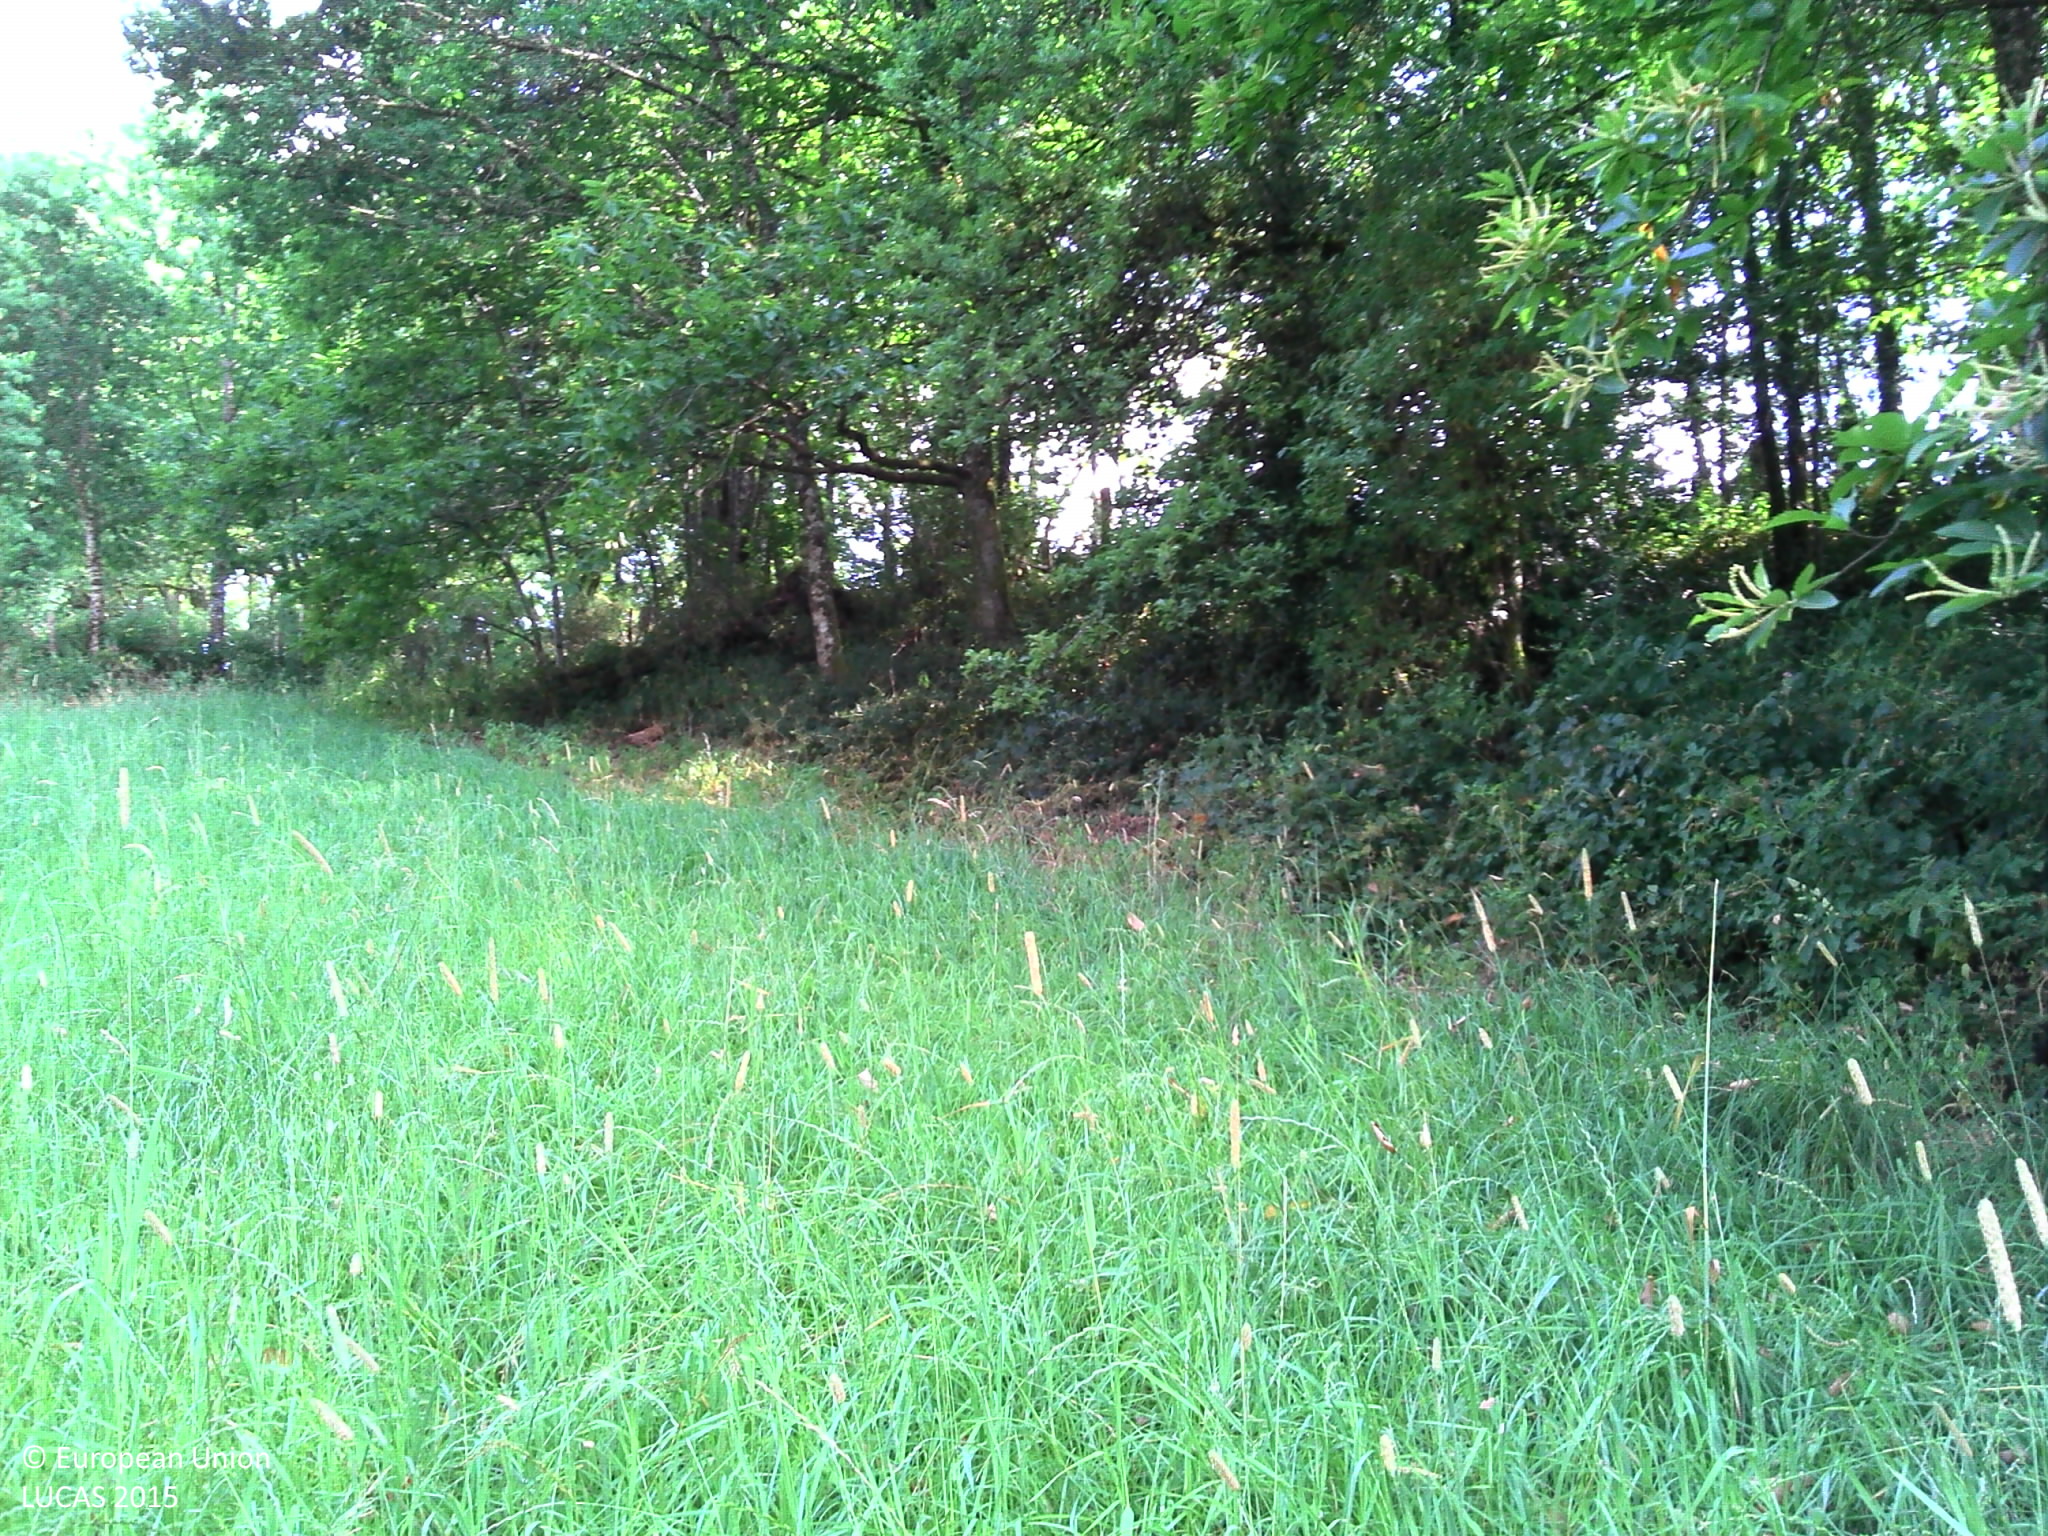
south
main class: Grassland
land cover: Grassland without tree/shrub cover
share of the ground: > 75 %
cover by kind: herbaceous plants 100 %
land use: Agriculture (excluding fallow land and kitchen gardens)
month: July
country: FR
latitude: 45.6713
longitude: 1.7661
